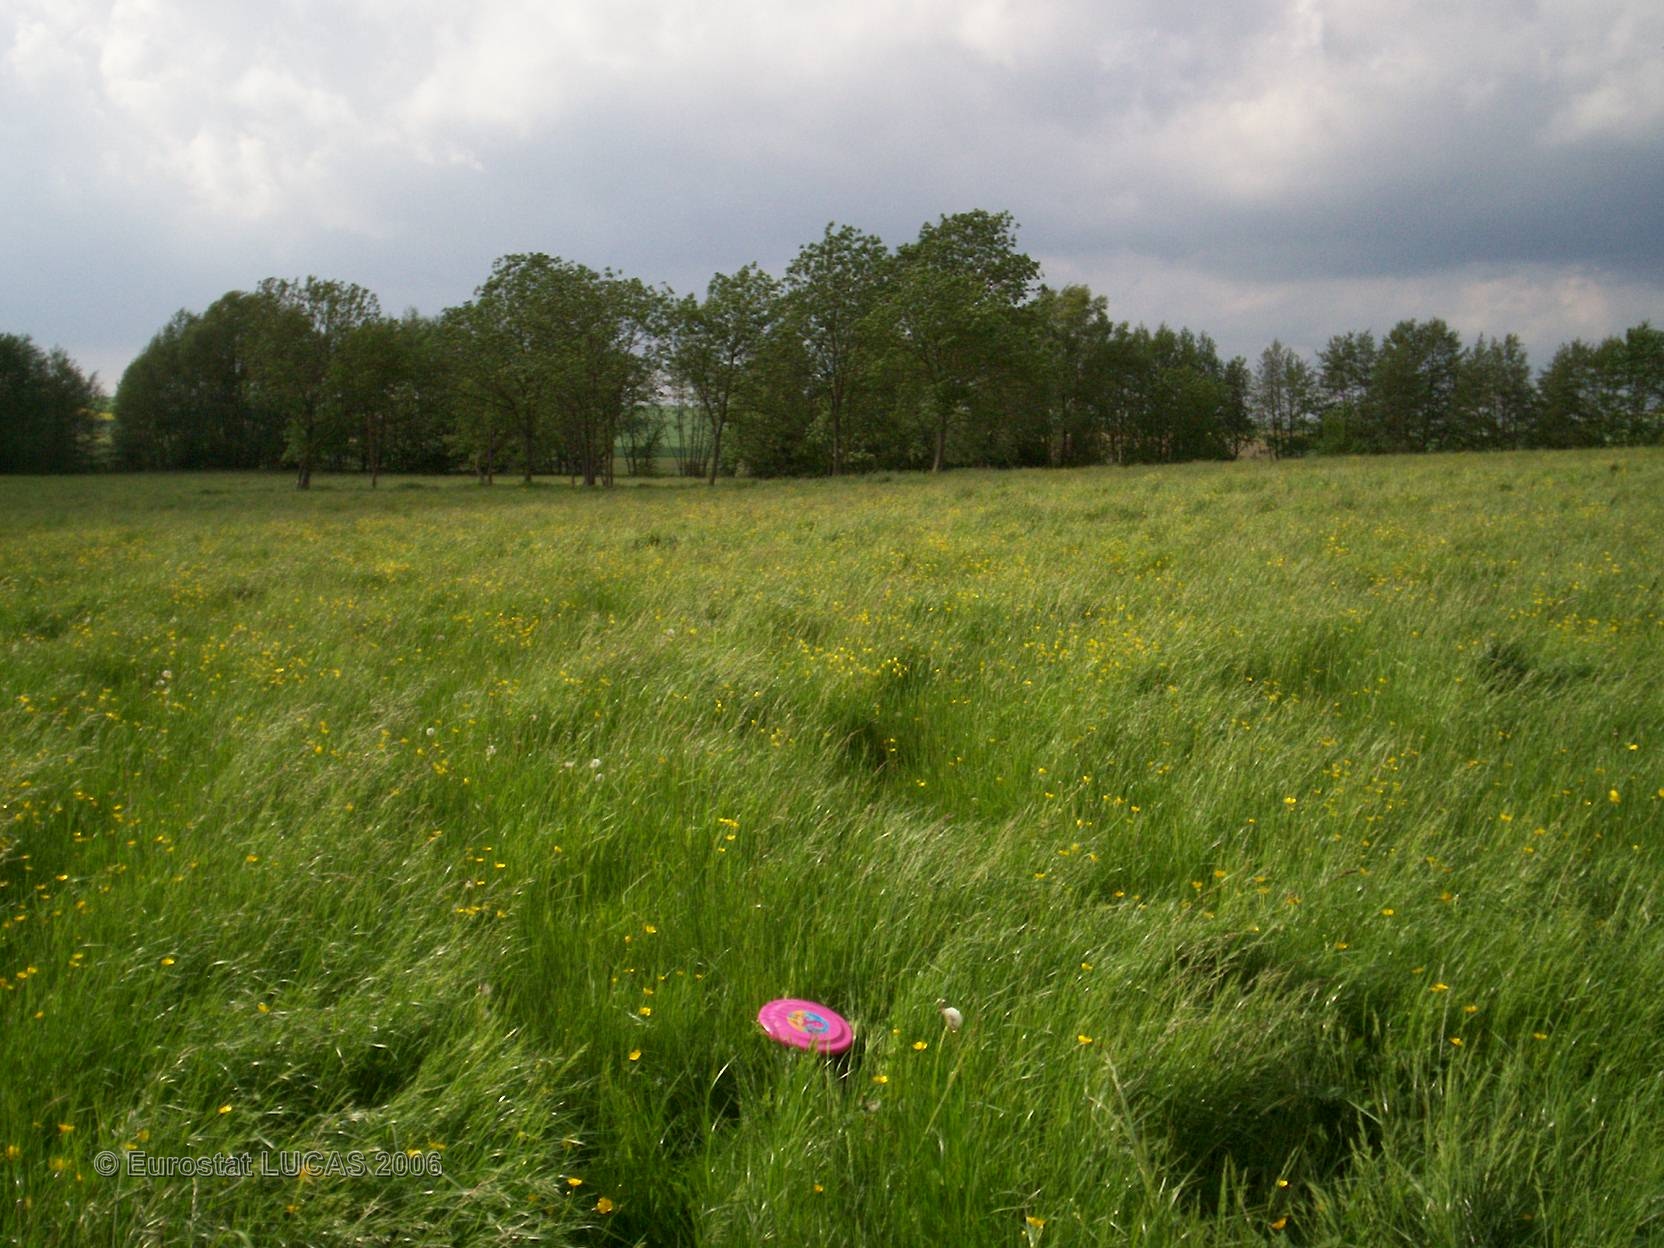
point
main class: Grassland
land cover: Grassland without tree/shrub cover
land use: Agriculture (excluding fallow land and kitchen gardens)
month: May
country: FR
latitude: 49.5570
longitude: 4.3417
